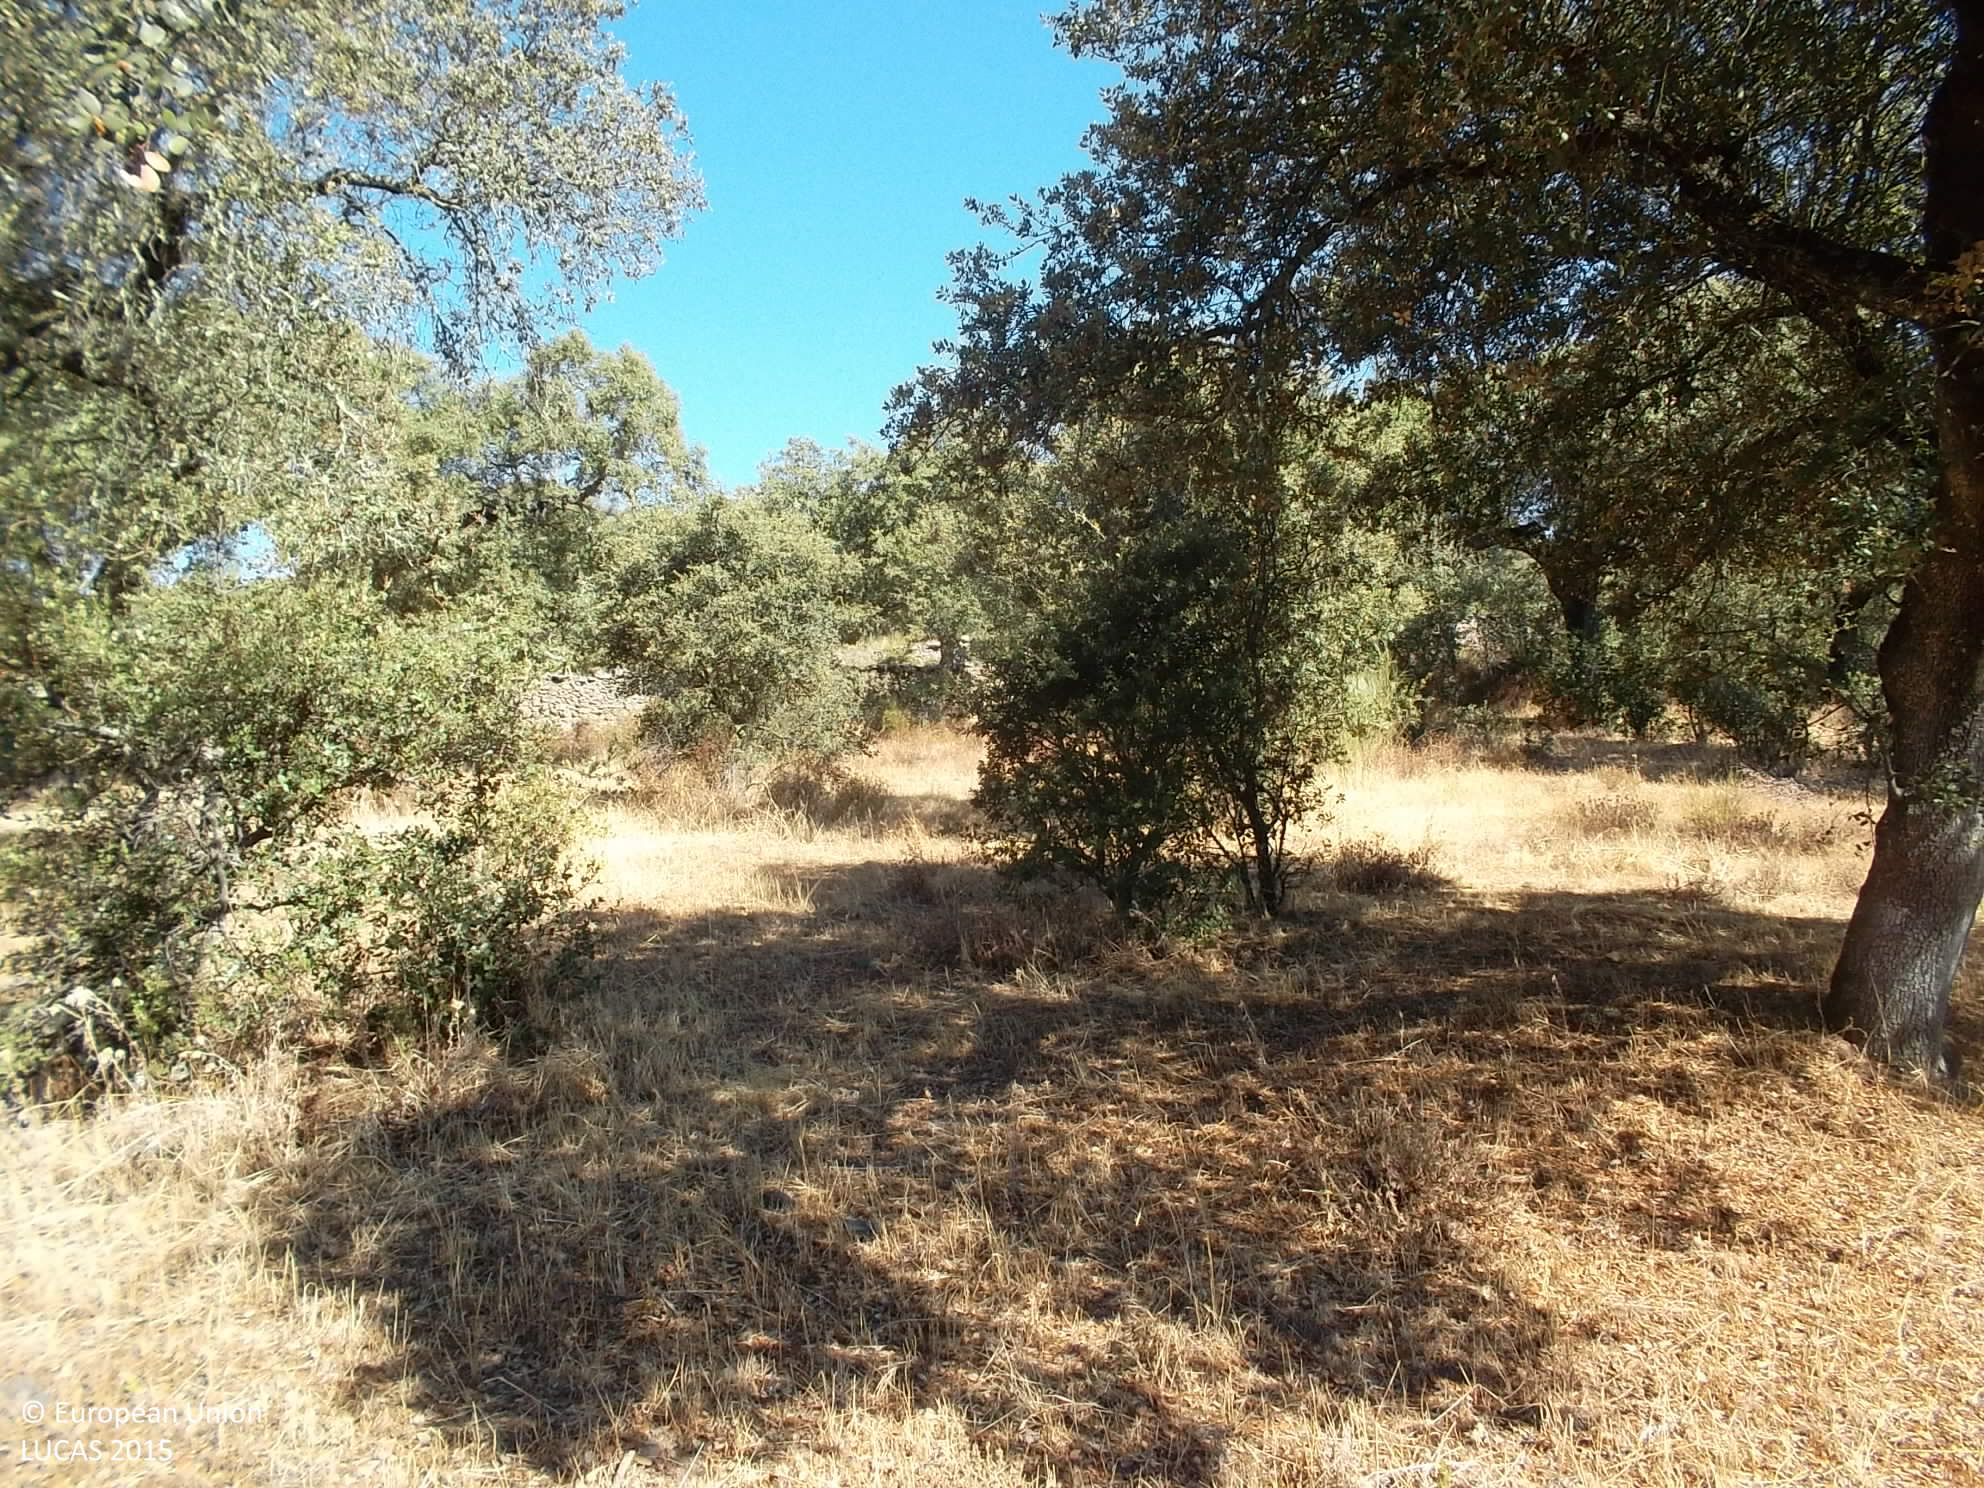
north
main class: Woodland
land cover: Broadleaved woodland
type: broadleaved evergreen forest
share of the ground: 50 - 75 %
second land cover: Shrubland without tree cover
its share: 10 - 25 %
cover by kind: broadleaved forest trees 50 %, herbaceous plants 30 %, shrubs 20 %
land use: Forestry
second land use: Agriculture (excluding fallow land and kitchen gardens)
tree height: < 5 m
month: August
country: ES
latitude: 38.5056
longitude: -6.6261
